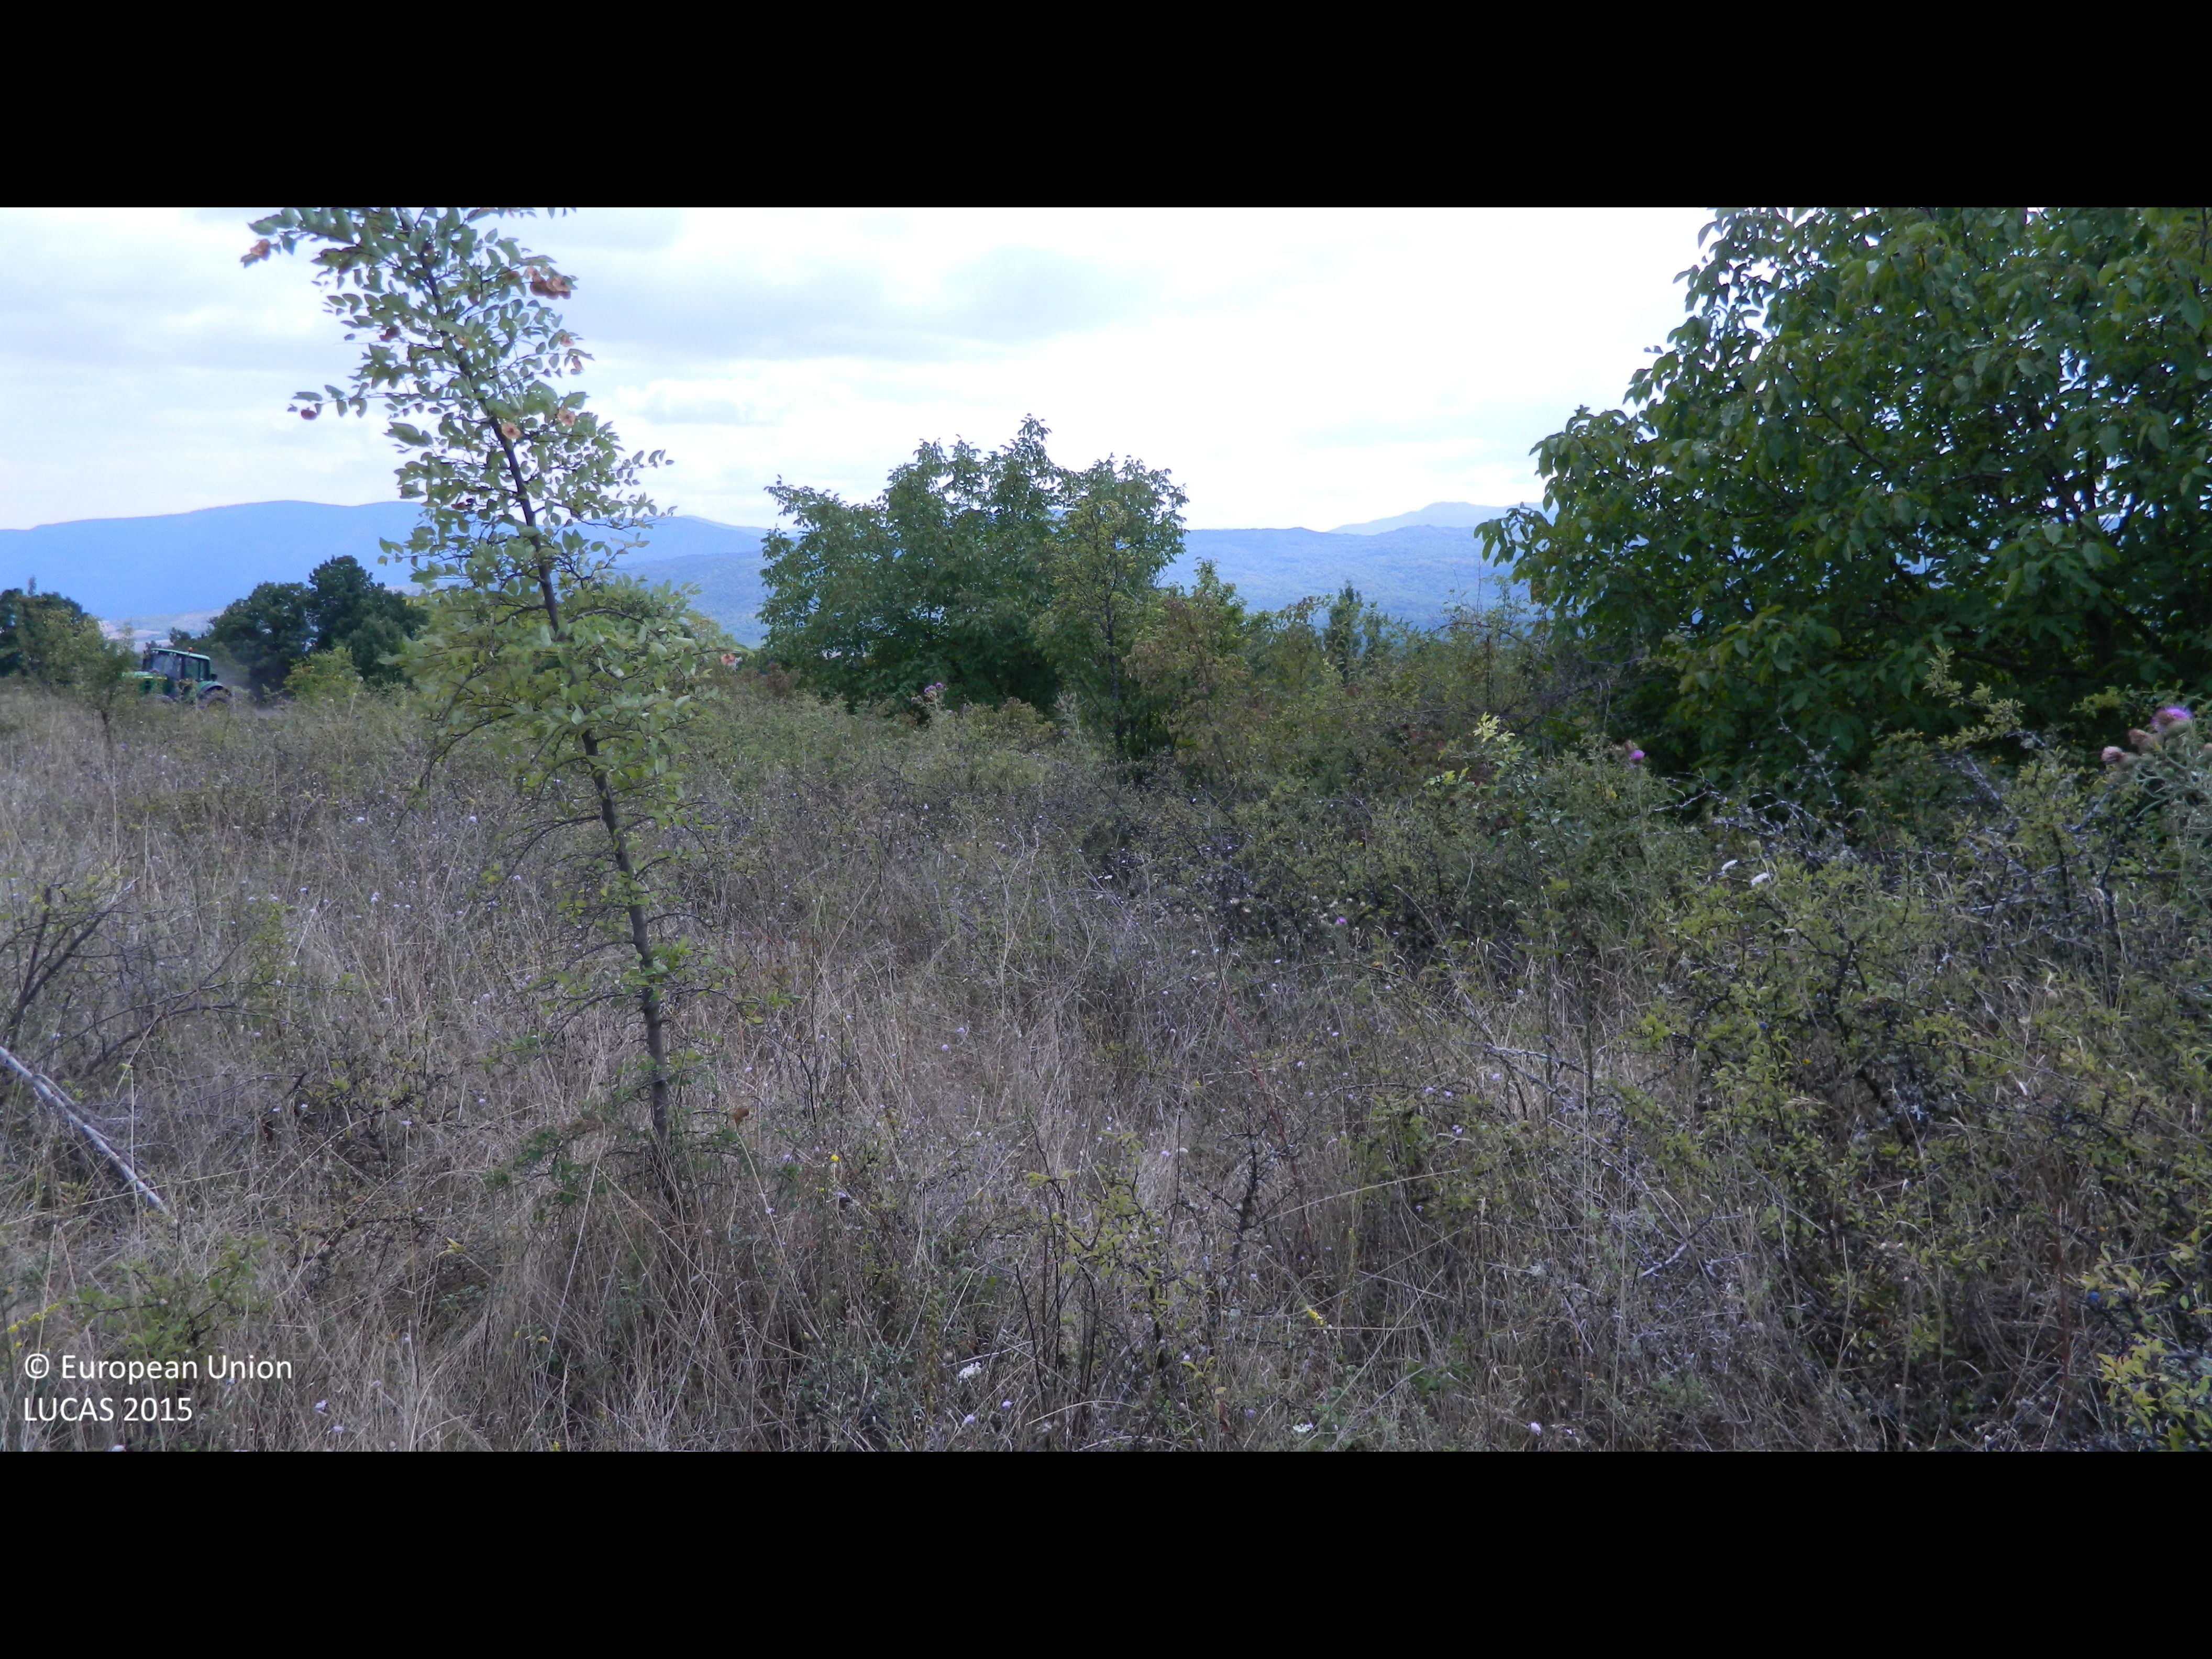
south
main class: Woodland
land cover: Broadleaved woodland
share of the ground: > 75 %
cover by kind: broadleaved forest trees 80 %, shrubs 10 %, herbaceous plants 10 %
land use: Semi-natural and natural areas not in use
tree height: > 5 m
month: August
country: BG
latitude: 41.7019
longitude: 25.8945
